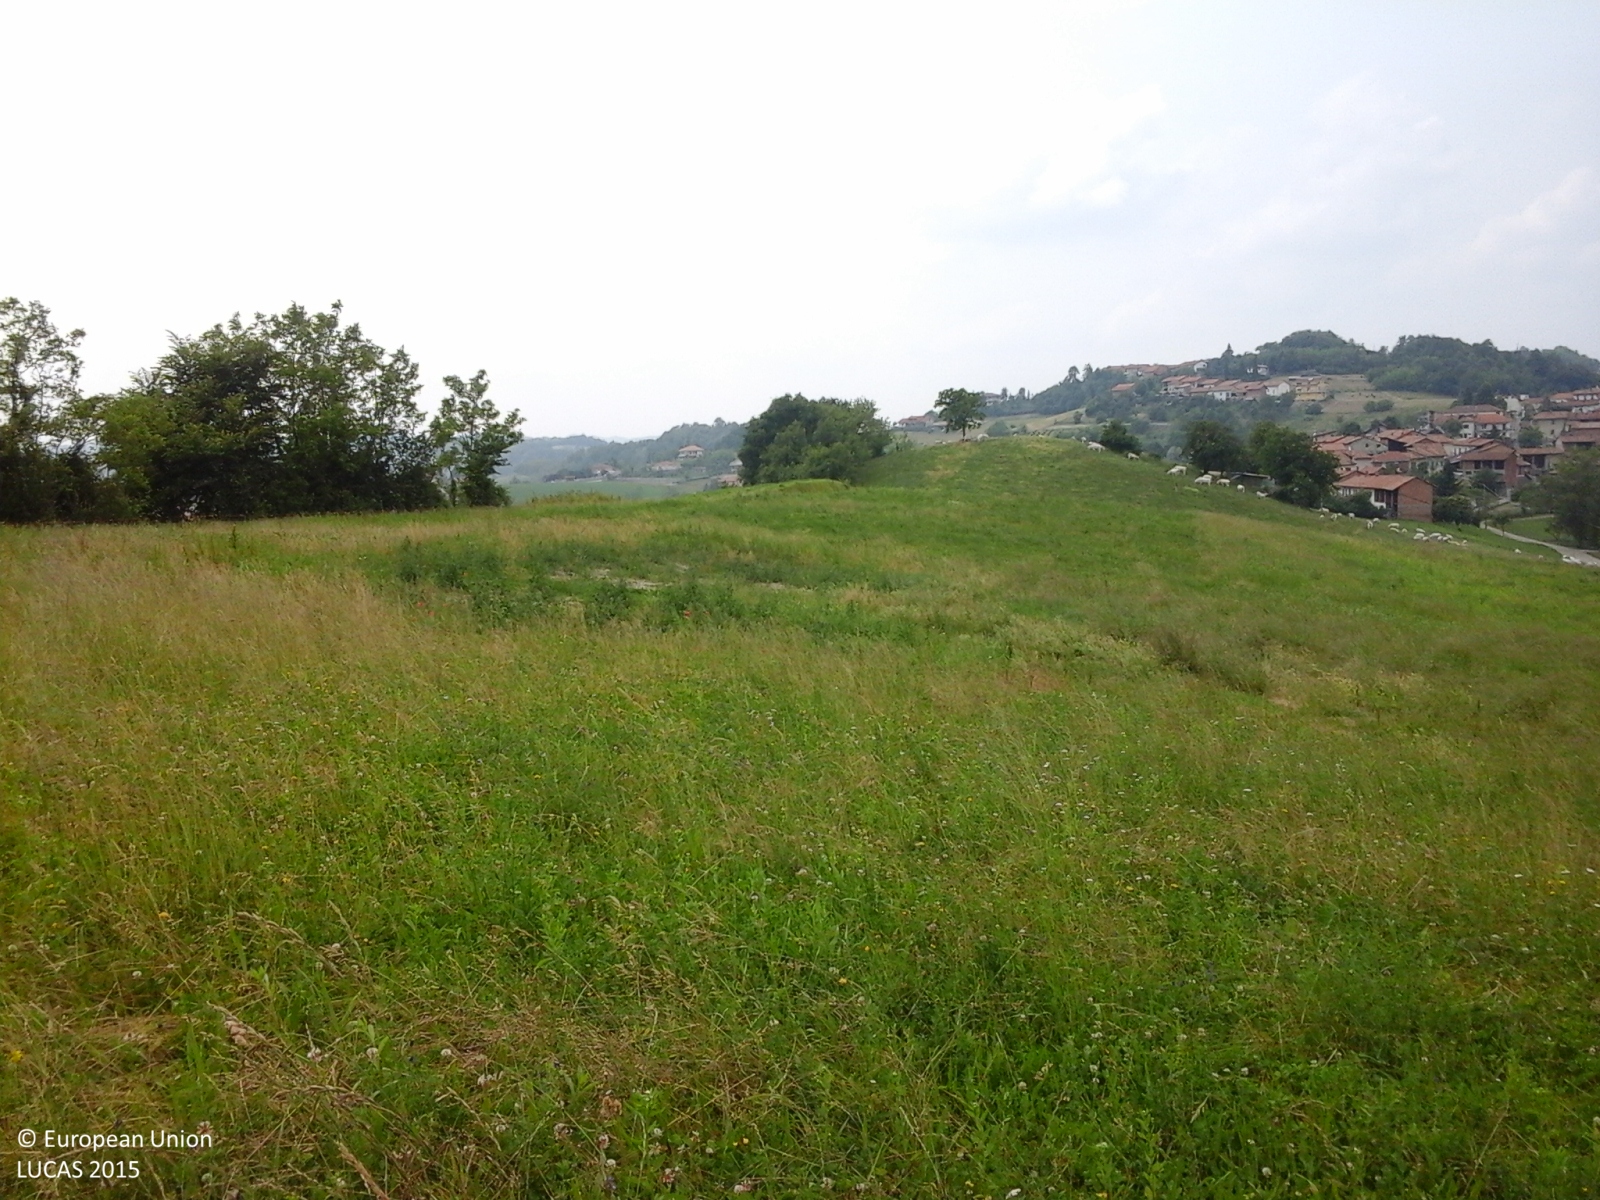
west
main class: Grassland
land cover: Grassland without tree/shrub cover
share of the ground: > 75 %
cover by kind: herbaceous plants 100 %
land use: Agriculture (excluding fallow land and kitchen gardens)
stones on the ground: 10 - 25 %
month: May
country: IT
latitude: 45.1089
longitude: 8.1096
